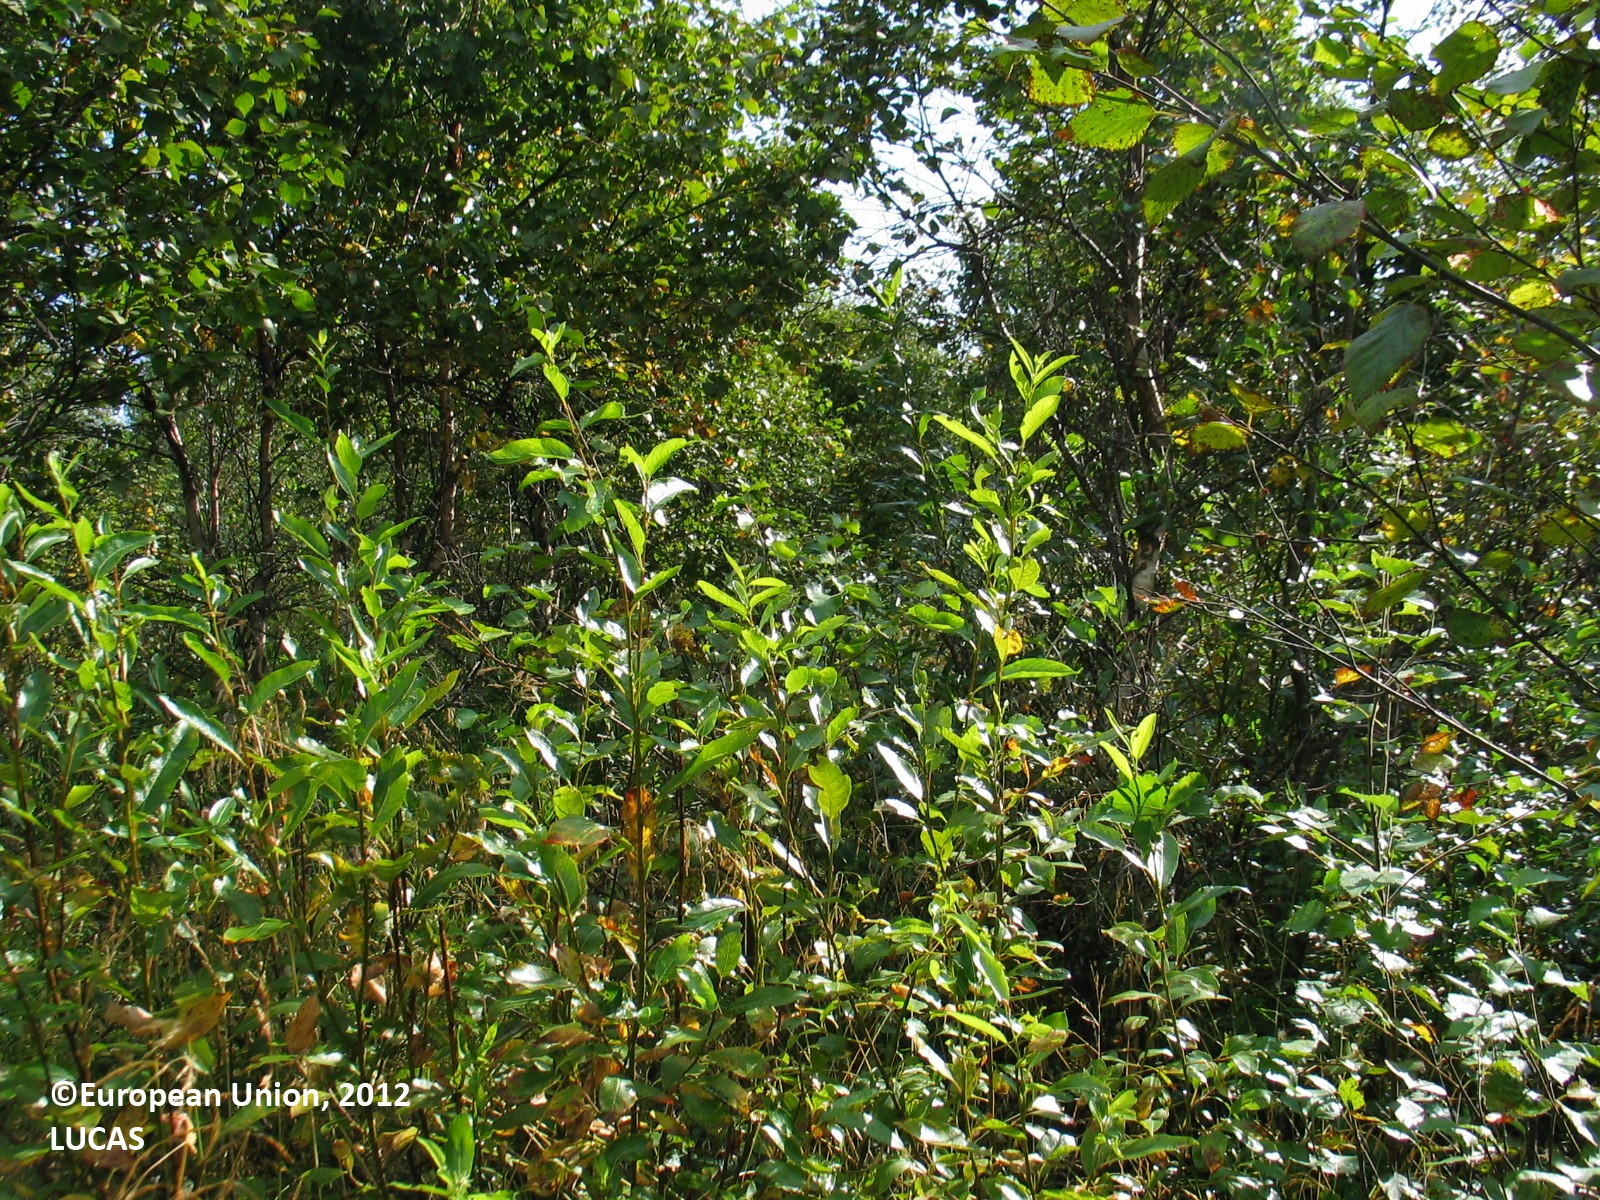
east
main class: Woodland
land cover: Broadleaved woodland
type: boreal forest
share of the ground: 25 - 50 %
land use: Forestry
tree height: > 5 m
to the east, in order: Broadleaved woodland; Ditches and canals; Broadleaved woodland; Ditches and canals; Shrubland without tree cover; Tracks; Shrubland without tree cover; Ditches and canals; Broadleaved woodland; Shrubland without tree cover; Other mixed woodland; Inland running water; Broadleaved woodland; Ditches and canals; Broadleaved woodland; Ditches and canals; Abandoned hedges; Tracks; Abandoned hedges; Ditches and canals; Shrubland without tree cover; Electric lines; Shrubland without tree cover; Other mixed woodland
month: August
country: FI
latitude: 65.5142
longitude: 26.4689
